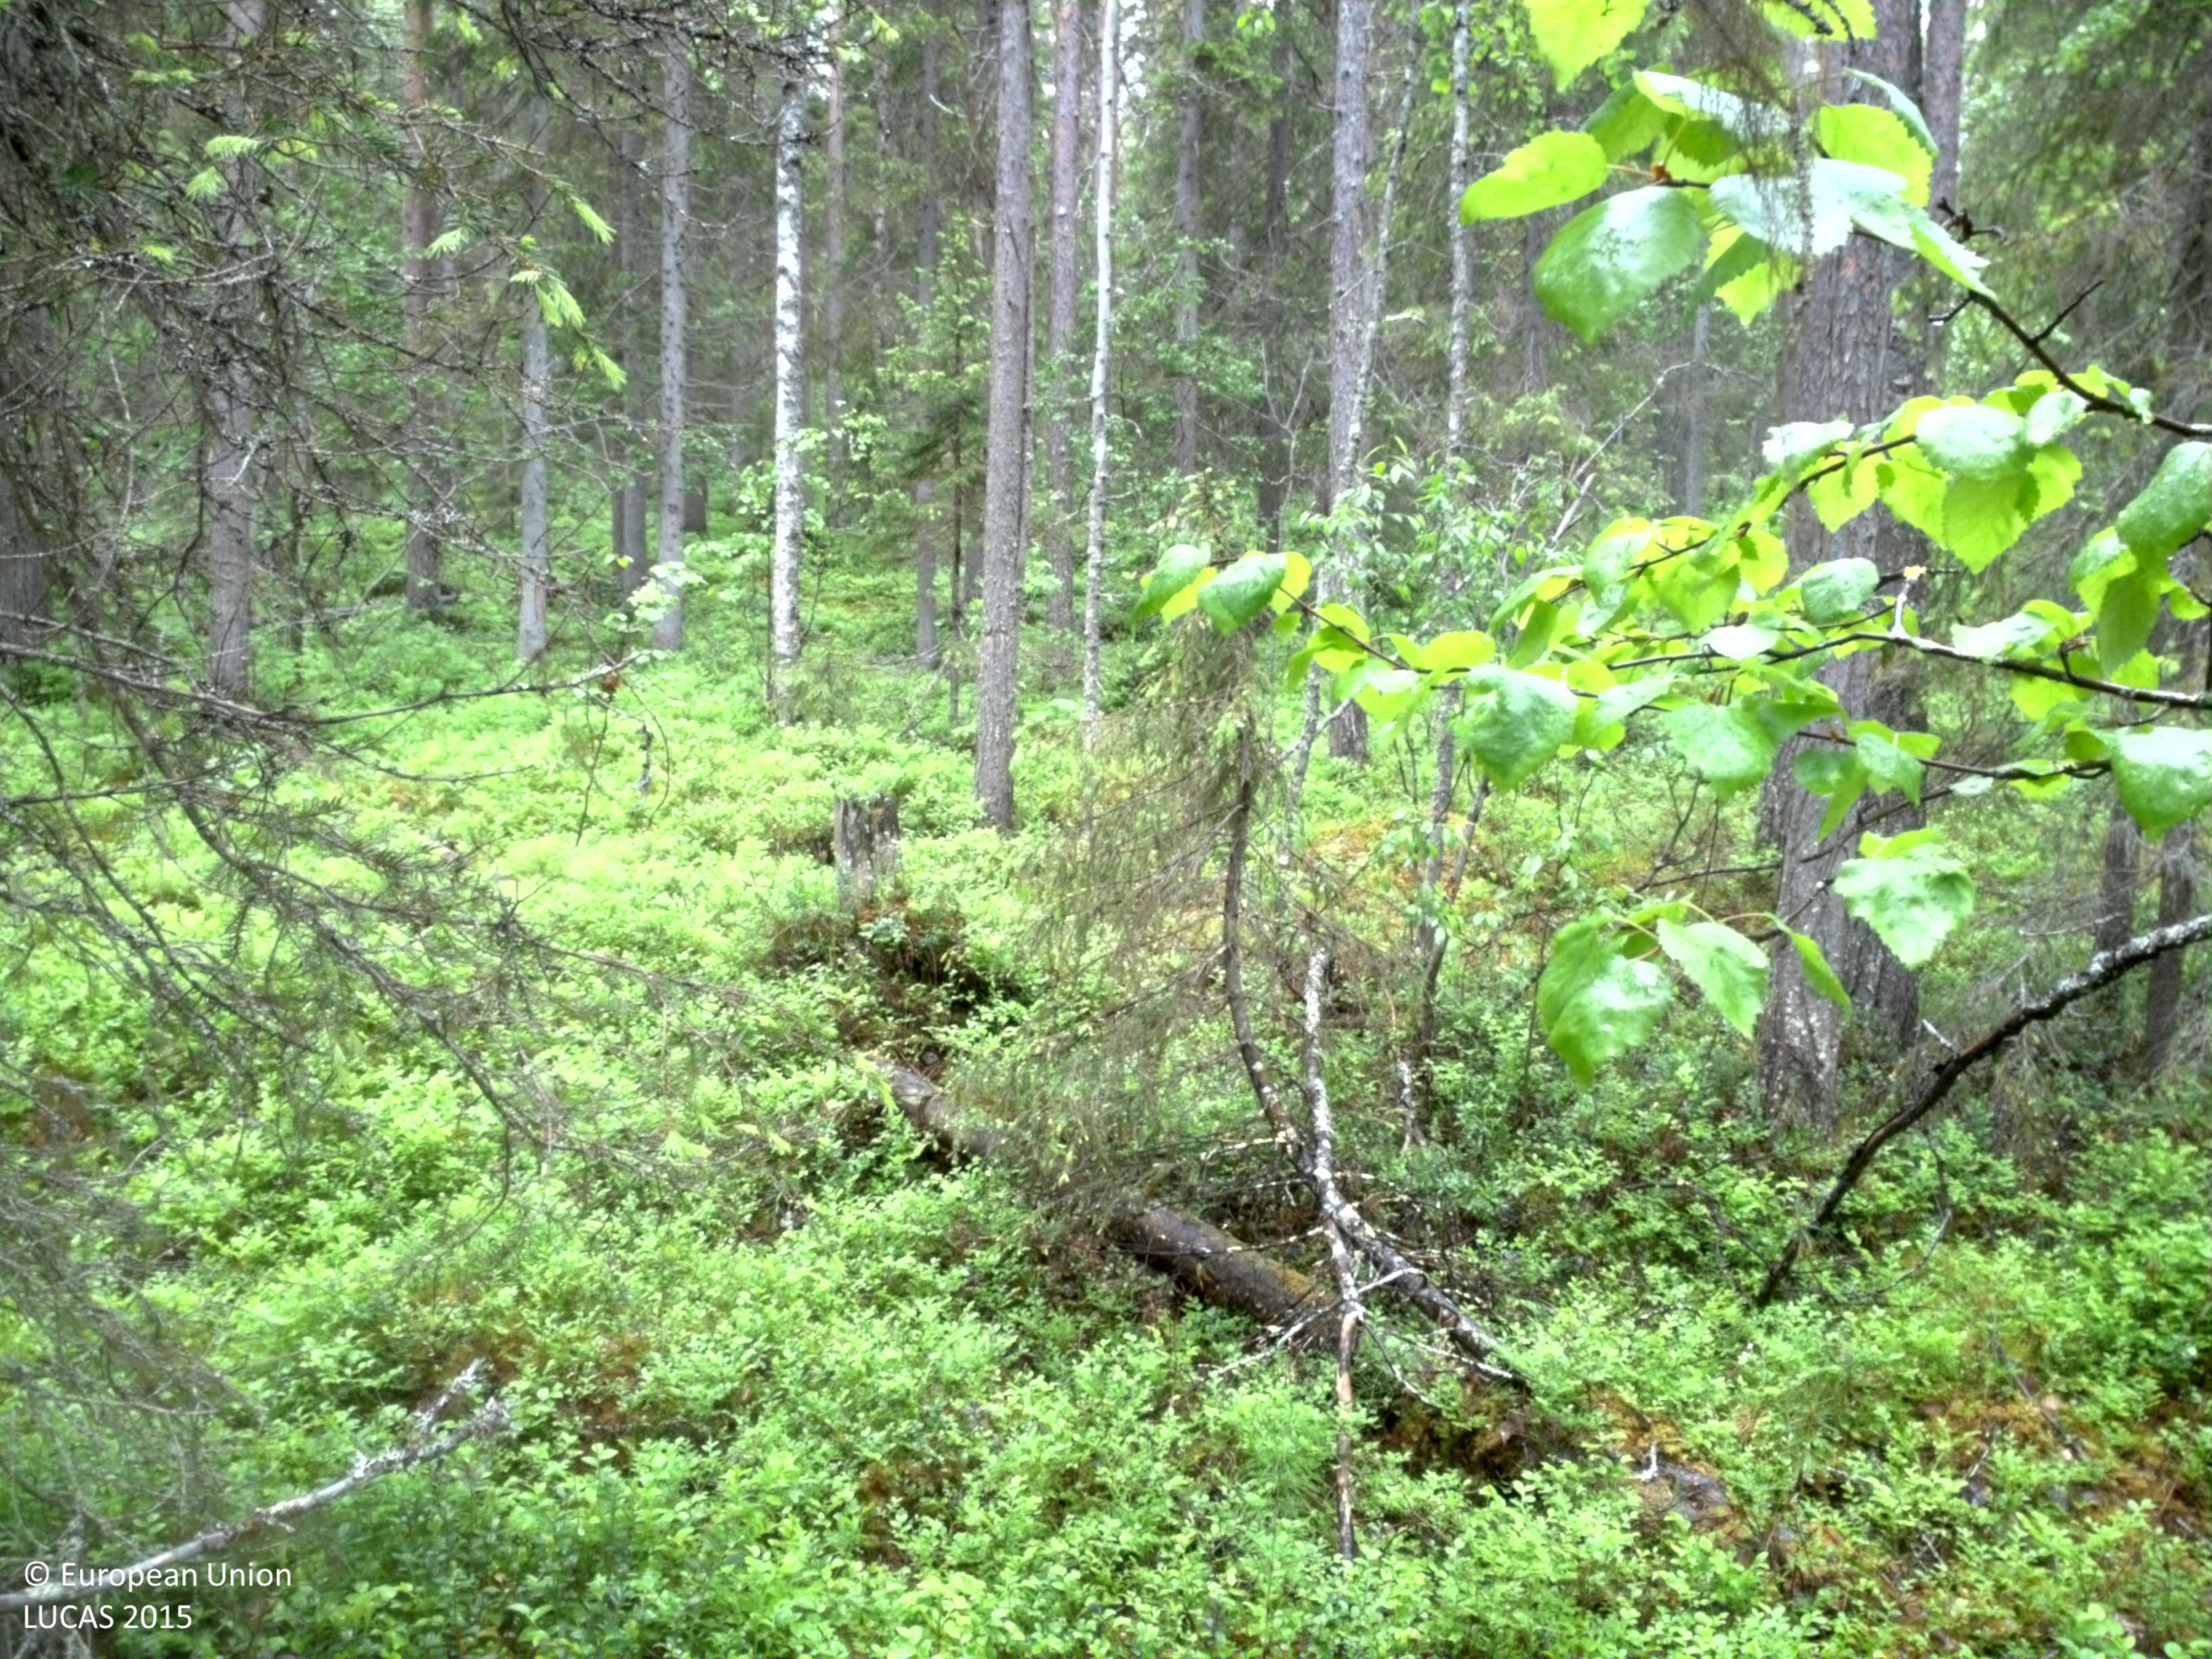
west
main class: Woodland
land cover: Pine dominated coniferous woodland
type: boreal forest
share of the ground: 25 - 50 %
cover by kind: shrubs 55 %, coniferous forest trees 40 %, broadleaved forest trees 5 %
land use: Forestry
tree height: > 5 m
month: June
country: SE
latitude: 66.4326
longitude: 22.7737
